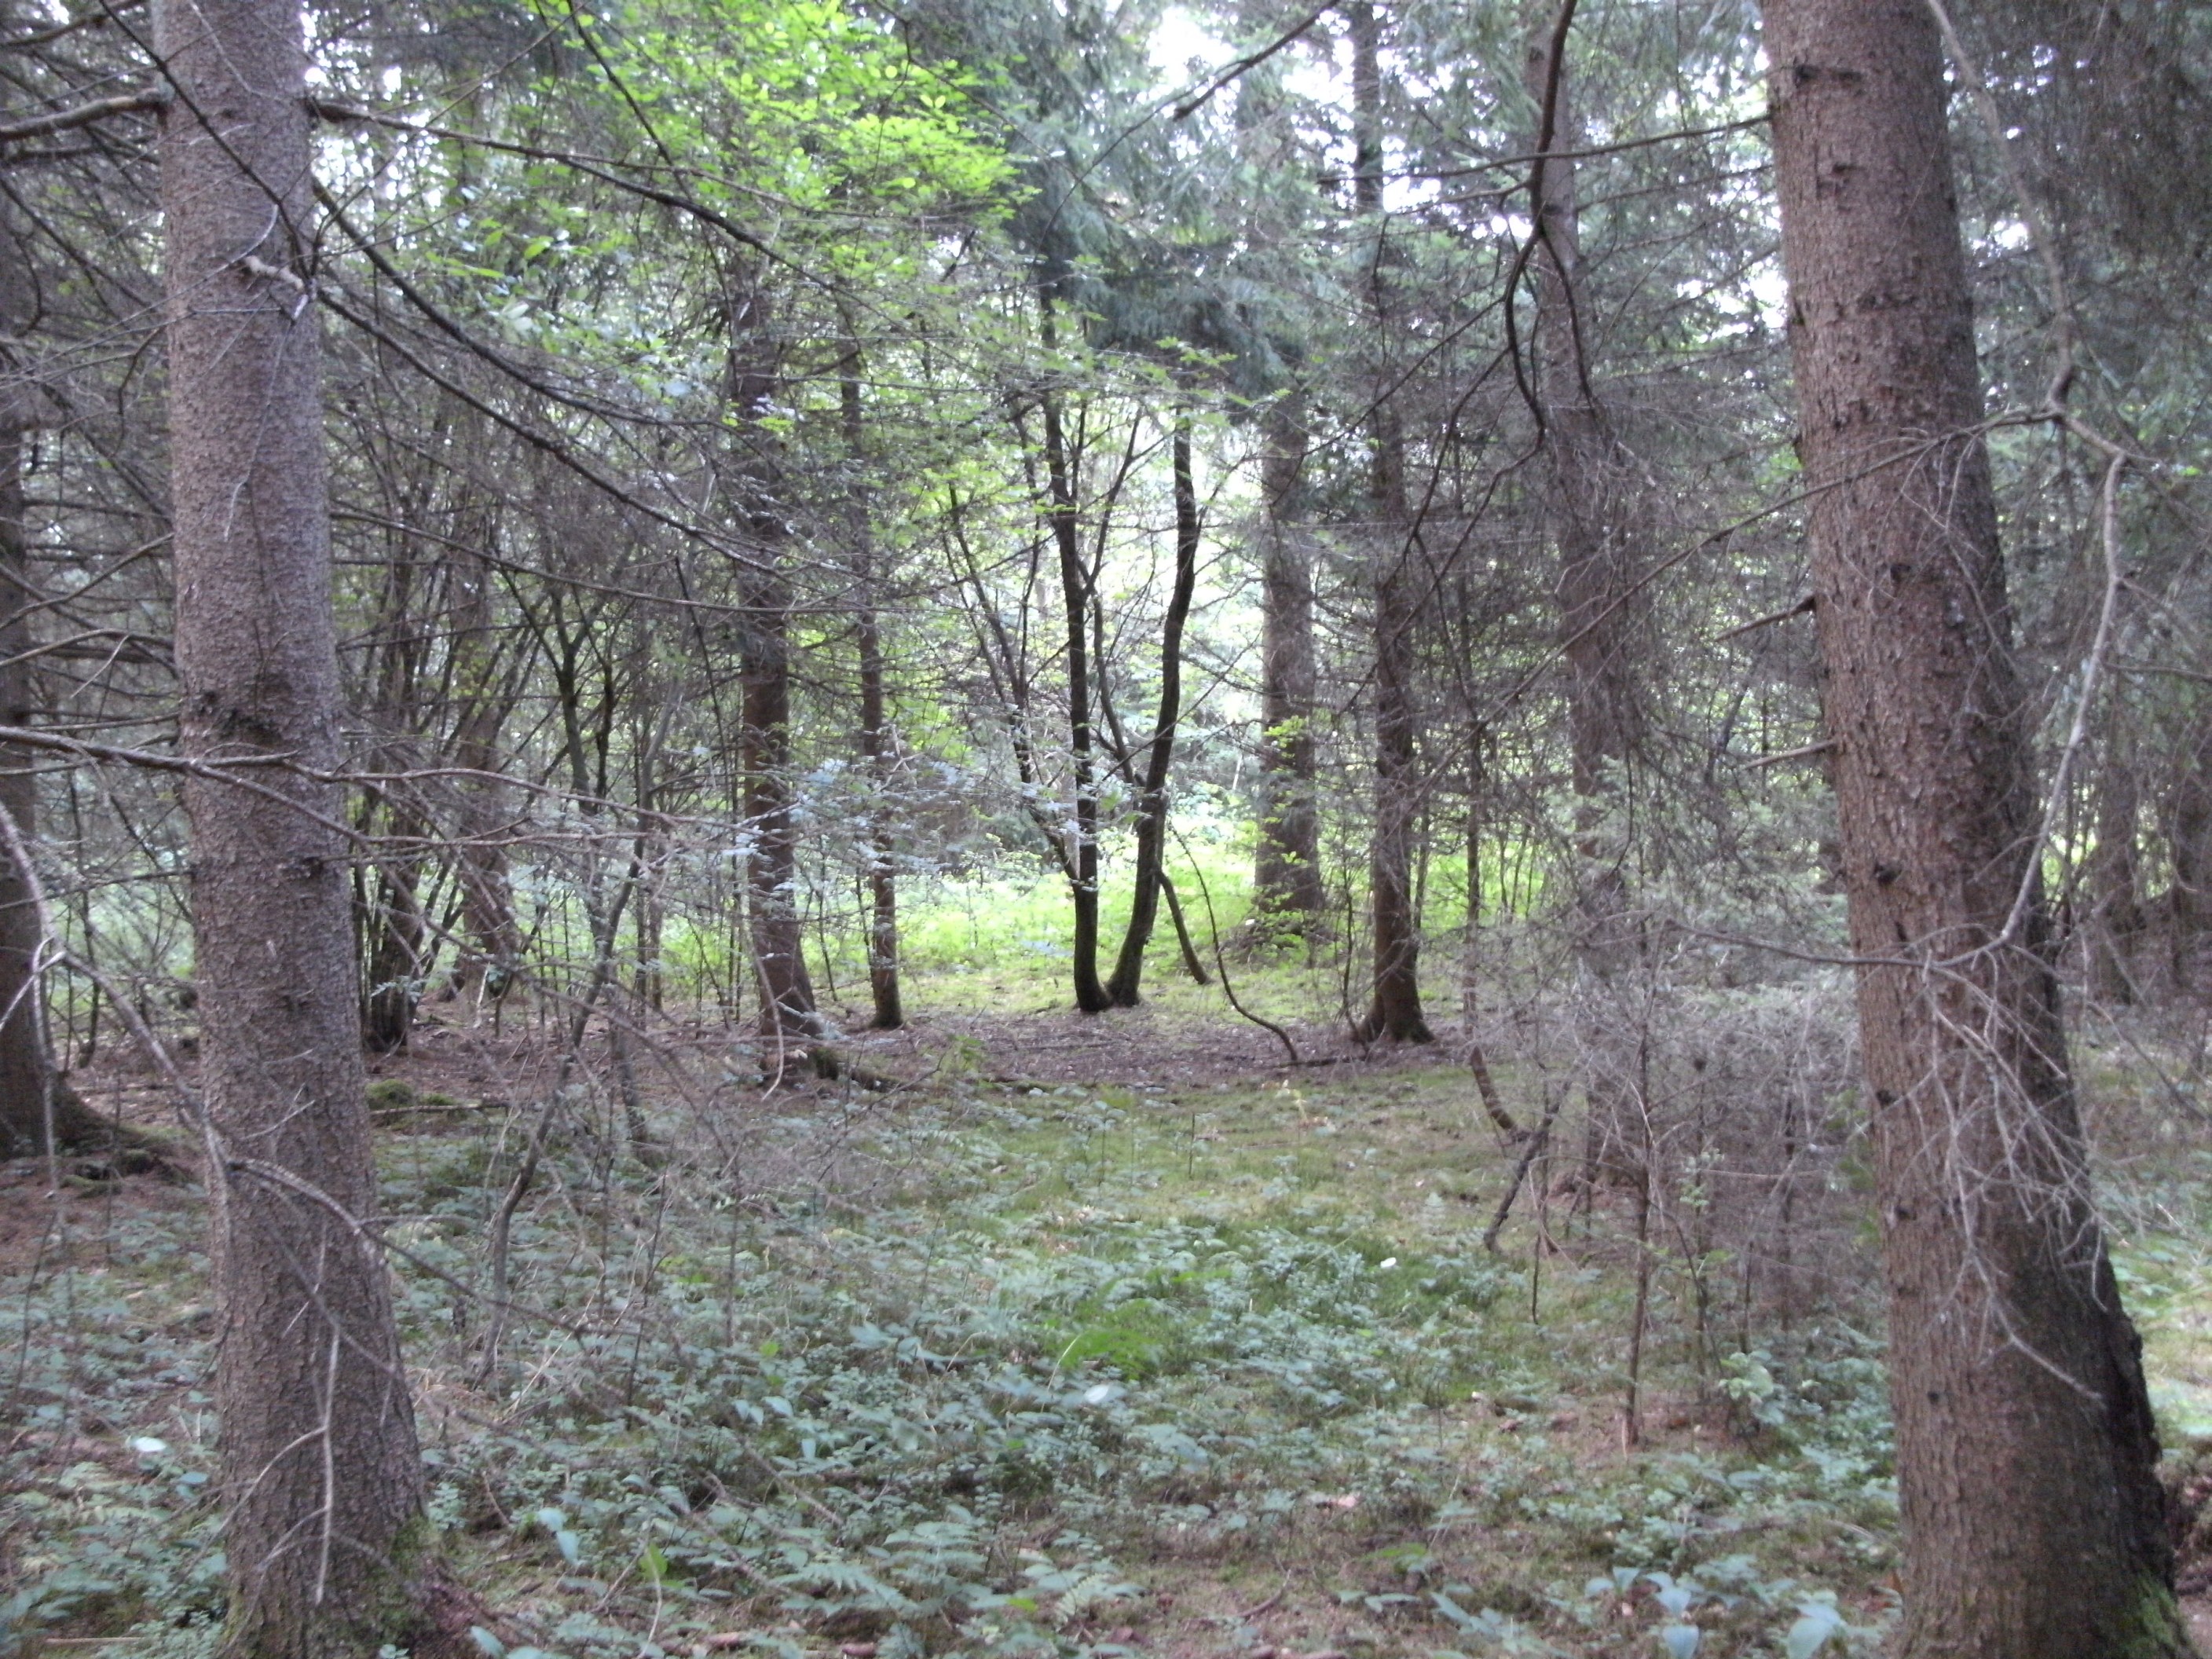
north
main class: Woodland
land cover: Spruce dominated coniferous woodland
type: hemiboreal forest and nemoral coniferous forest and mixed broadleaved-coniferous forest
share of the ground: > 75 %
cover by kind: coniferous forest trees 75 %, broadleaved forest trees 15 %, shrubs 5 %, herbaceous plants 5 %
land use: Forestry
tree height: > 5 m
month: July
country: AT
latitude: 46.6059
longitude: 14.7631
